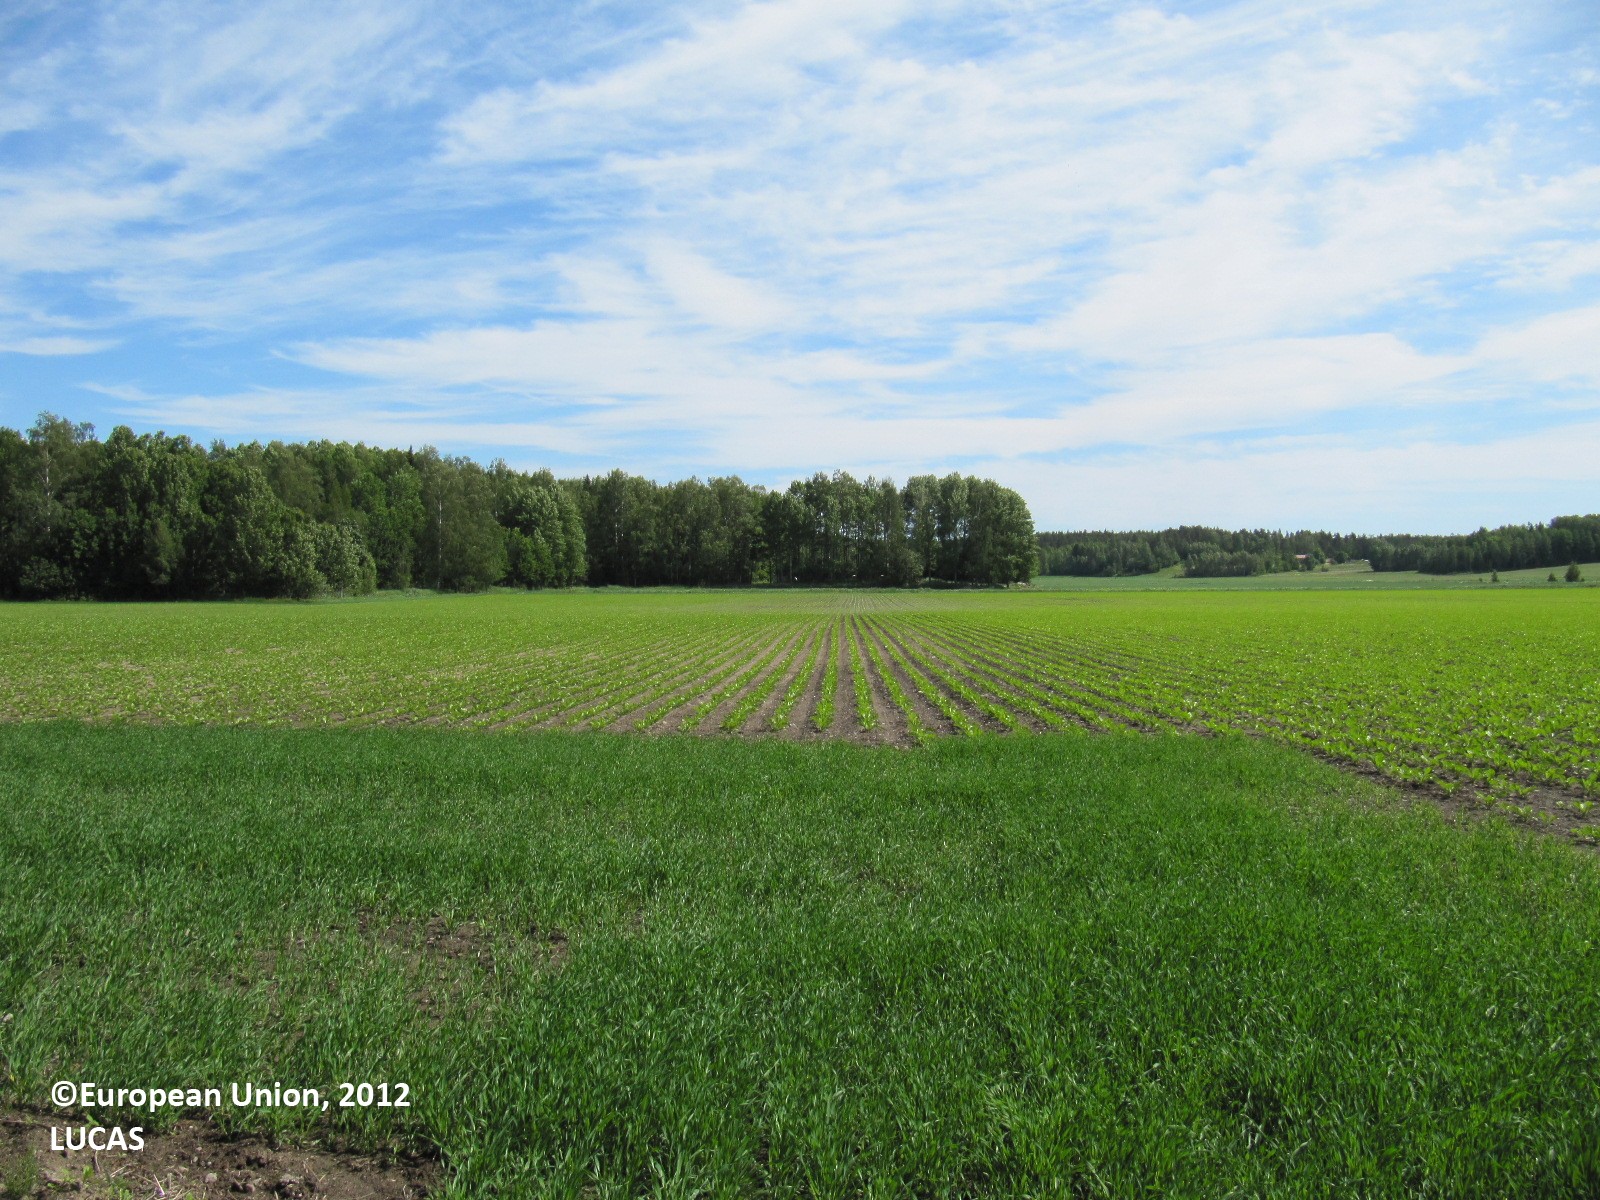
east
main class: Cropland
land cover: Sugar beet
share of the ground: 50 - 75 %
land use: Agriculture (excluding fallow land and kitchen gardens)
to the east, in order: Sugar beet
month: June
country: FI
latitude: 59.9667
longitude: 22.9233
